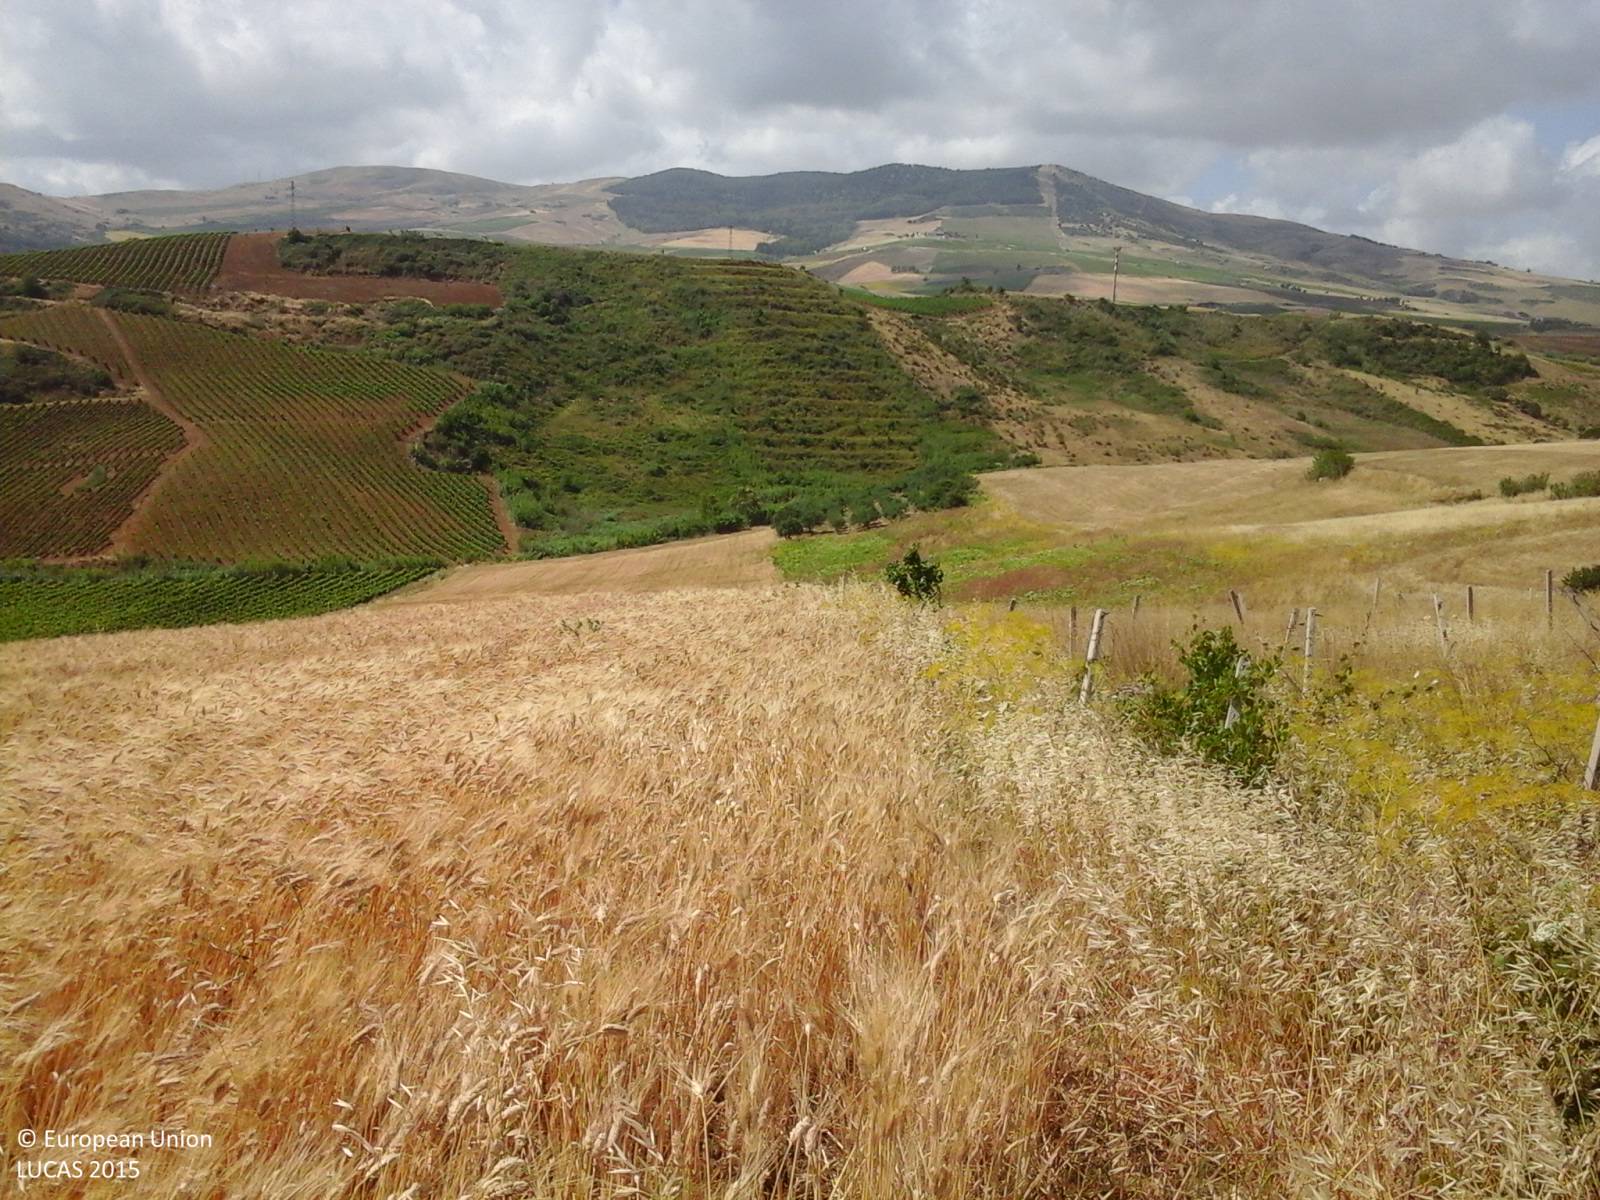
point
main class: Cropland
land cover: Durum wheat
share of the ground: > 75 %
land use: Agriculture (excluding fallow land and kitchen gardens)
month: June
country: IT
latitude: 38.0341
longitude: 12.7714
